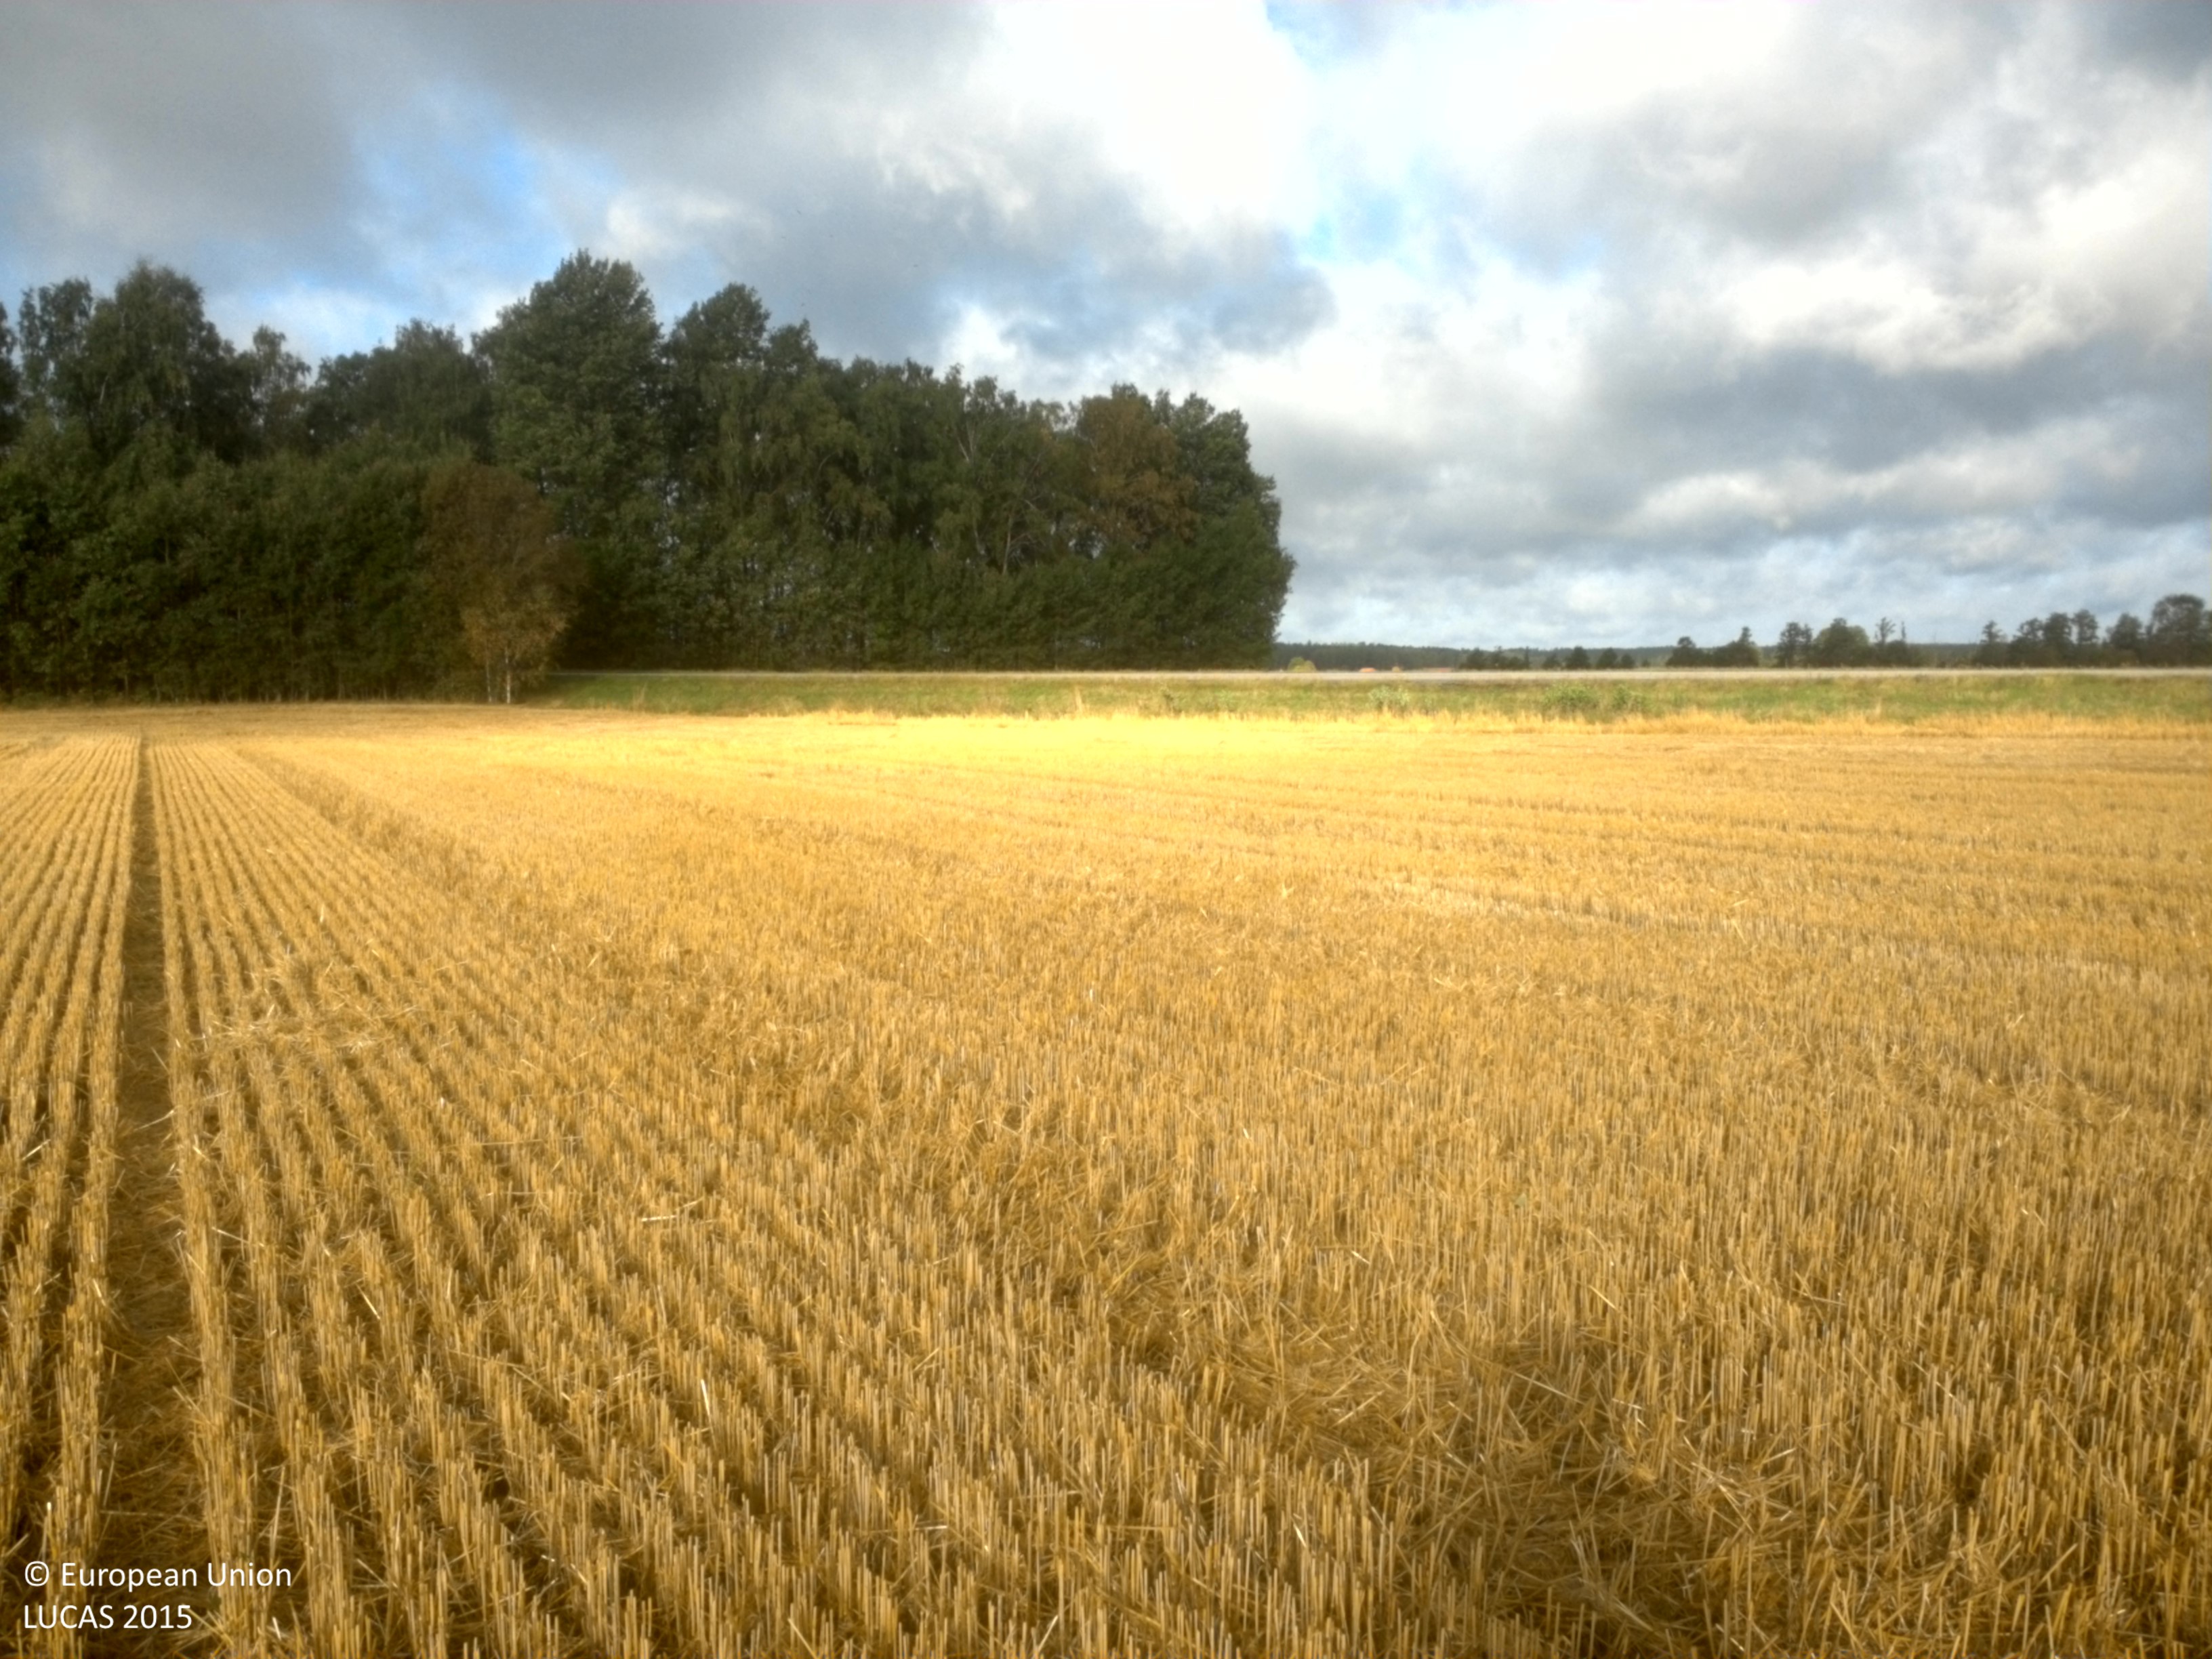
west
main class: Cropland
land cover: Common wheat
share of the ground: > 75 %
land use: Agriculture (excluding fallow land and kitchen gardens)
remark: Harvested field
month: August
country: SE
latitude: 59.5151
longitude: 15.9116
